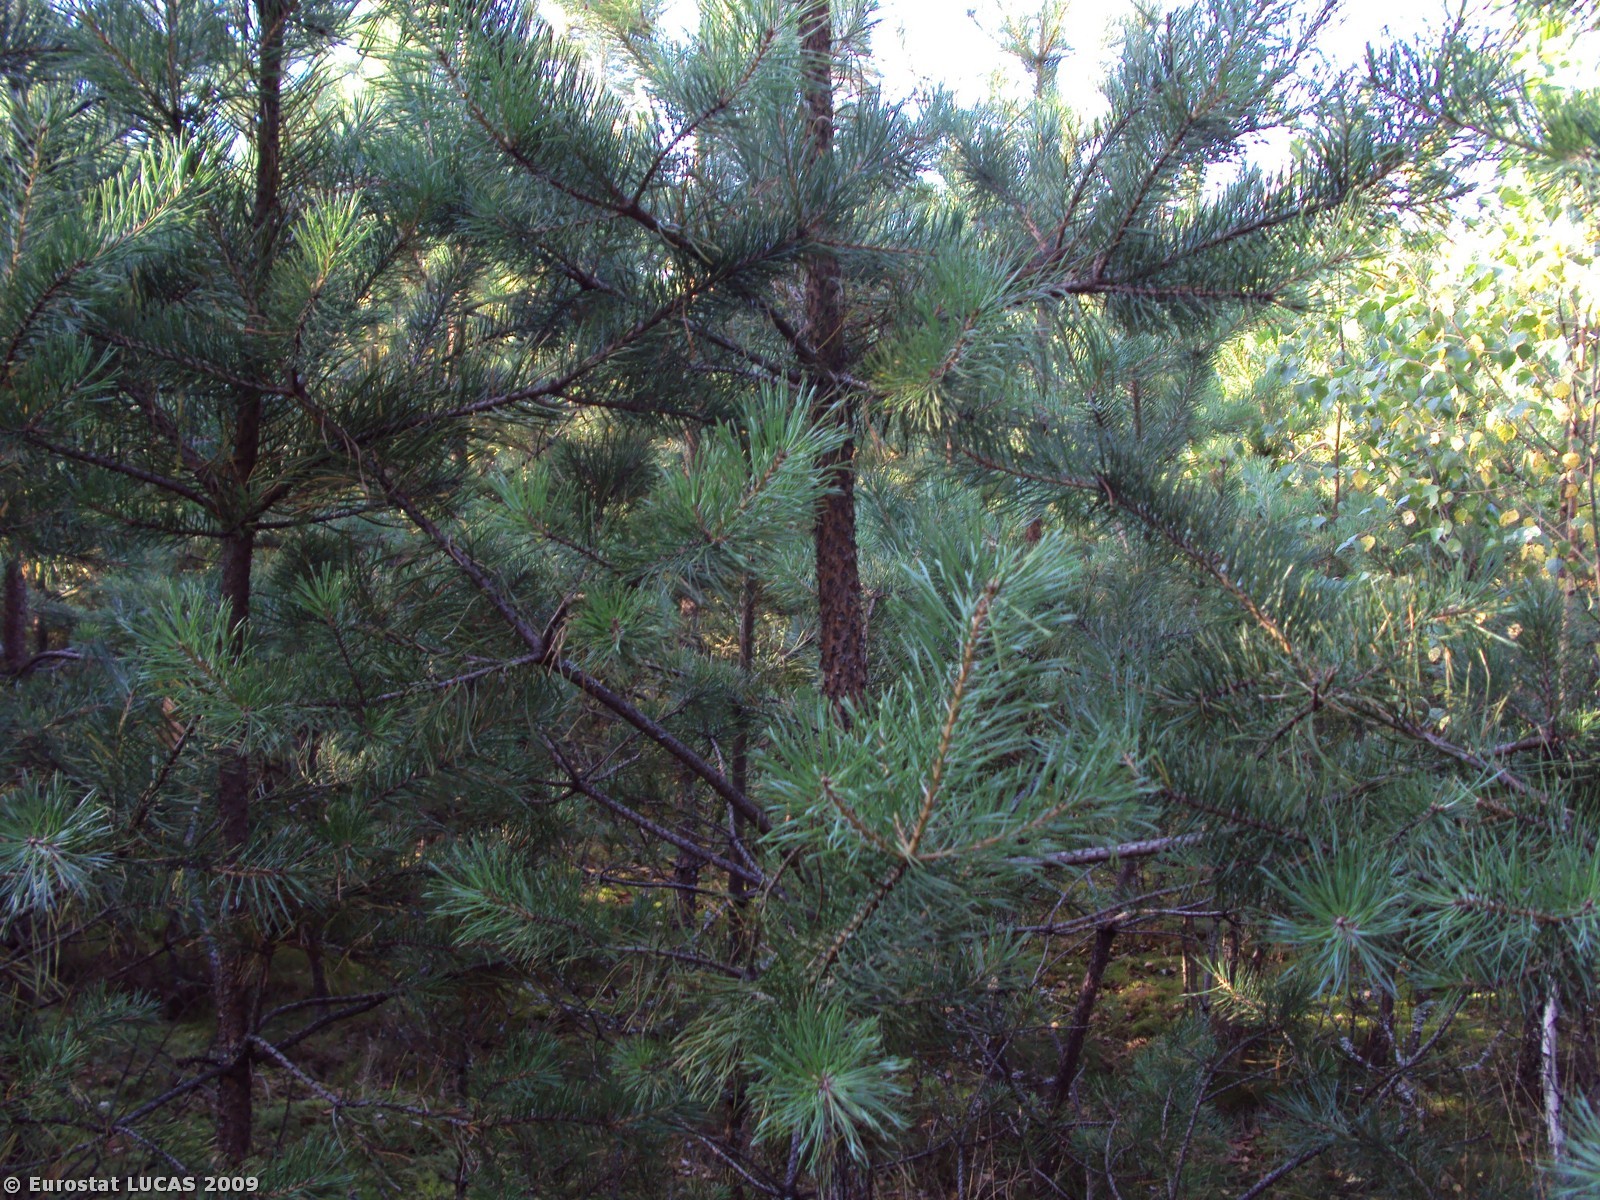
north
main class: Woodland
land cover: Coniferous woodland
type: hemiboreal forest and nemoral coniferous forest and mixed broadleaved-coniferous forest
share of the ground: > 75 %
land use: Forestry
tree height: > 5 m
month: August
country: PL
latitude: 53.2960
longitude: 16.5638
